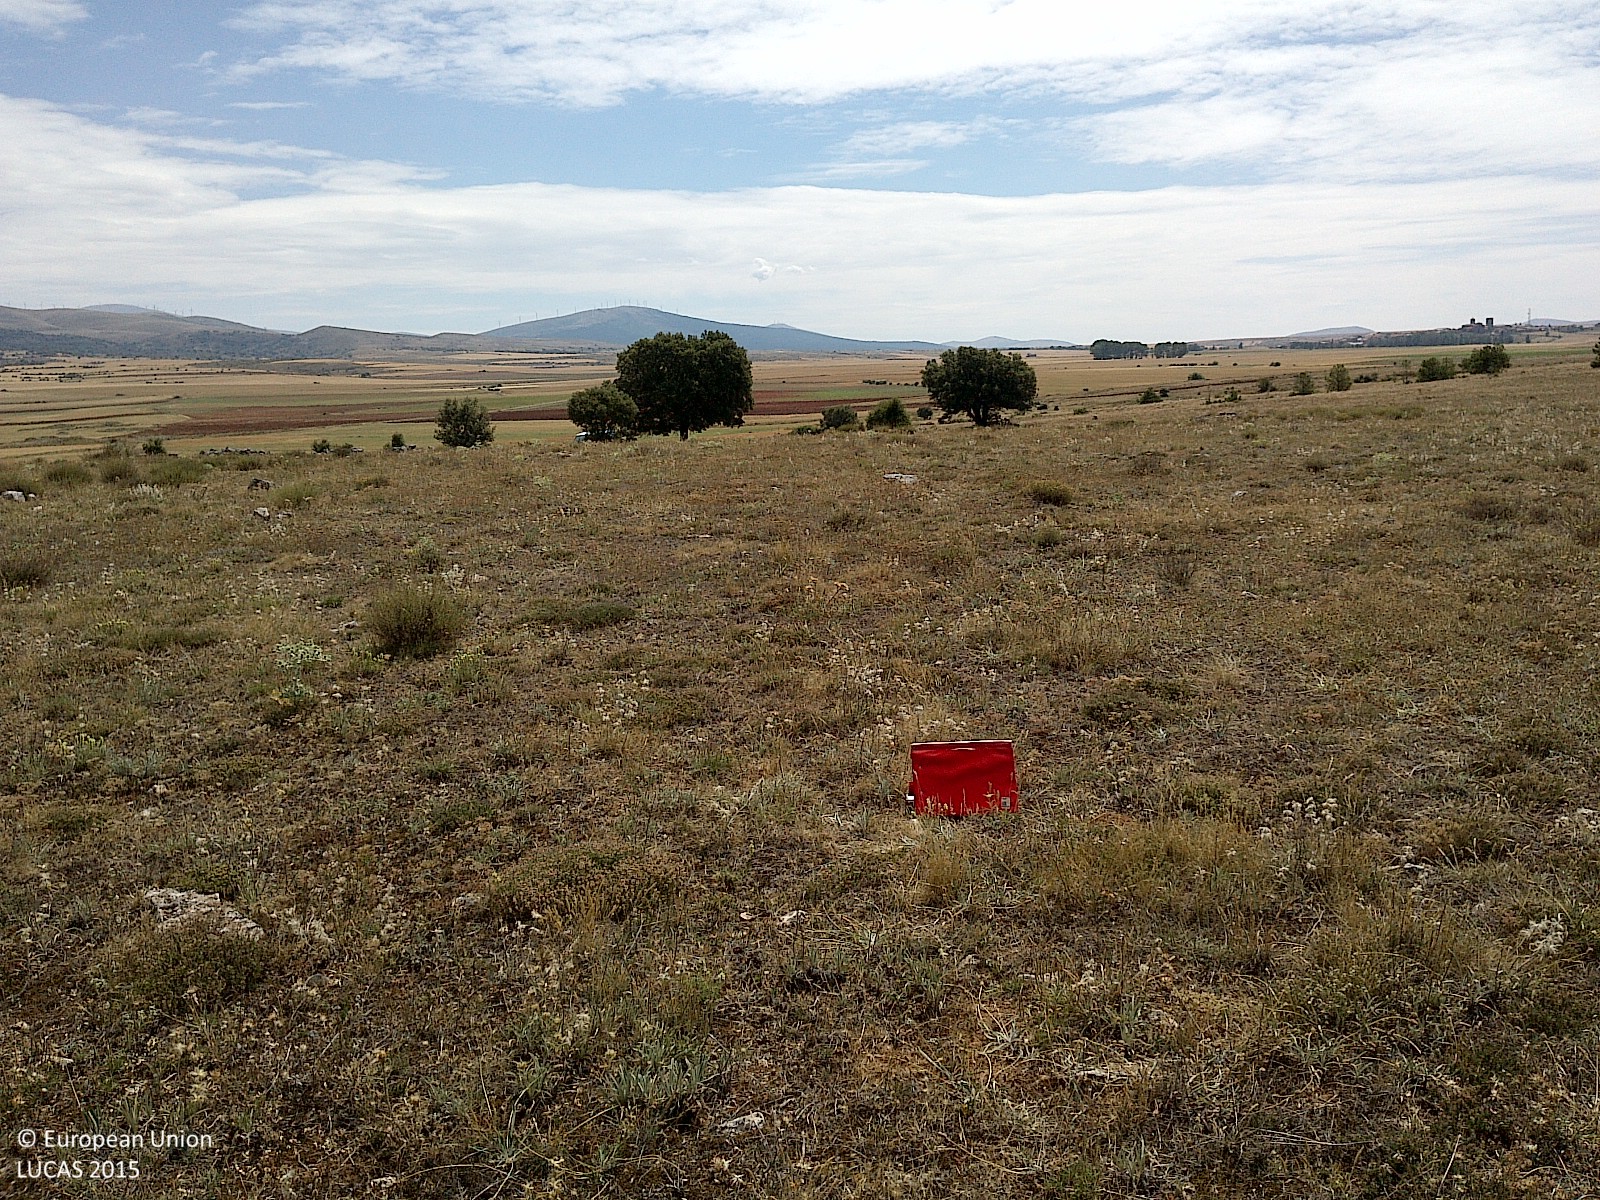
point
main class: Grassland
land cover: Grassland without tree/shrub cover
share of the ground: 50 - 75 %
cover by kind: herbaceous plants 70 %, lichens and mosses 25 %, shrubs 5 %
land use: Agriculture (excluding fallow land and kitchen gardens)
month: July
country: ES
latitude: 41.7291
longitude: -2.0672
